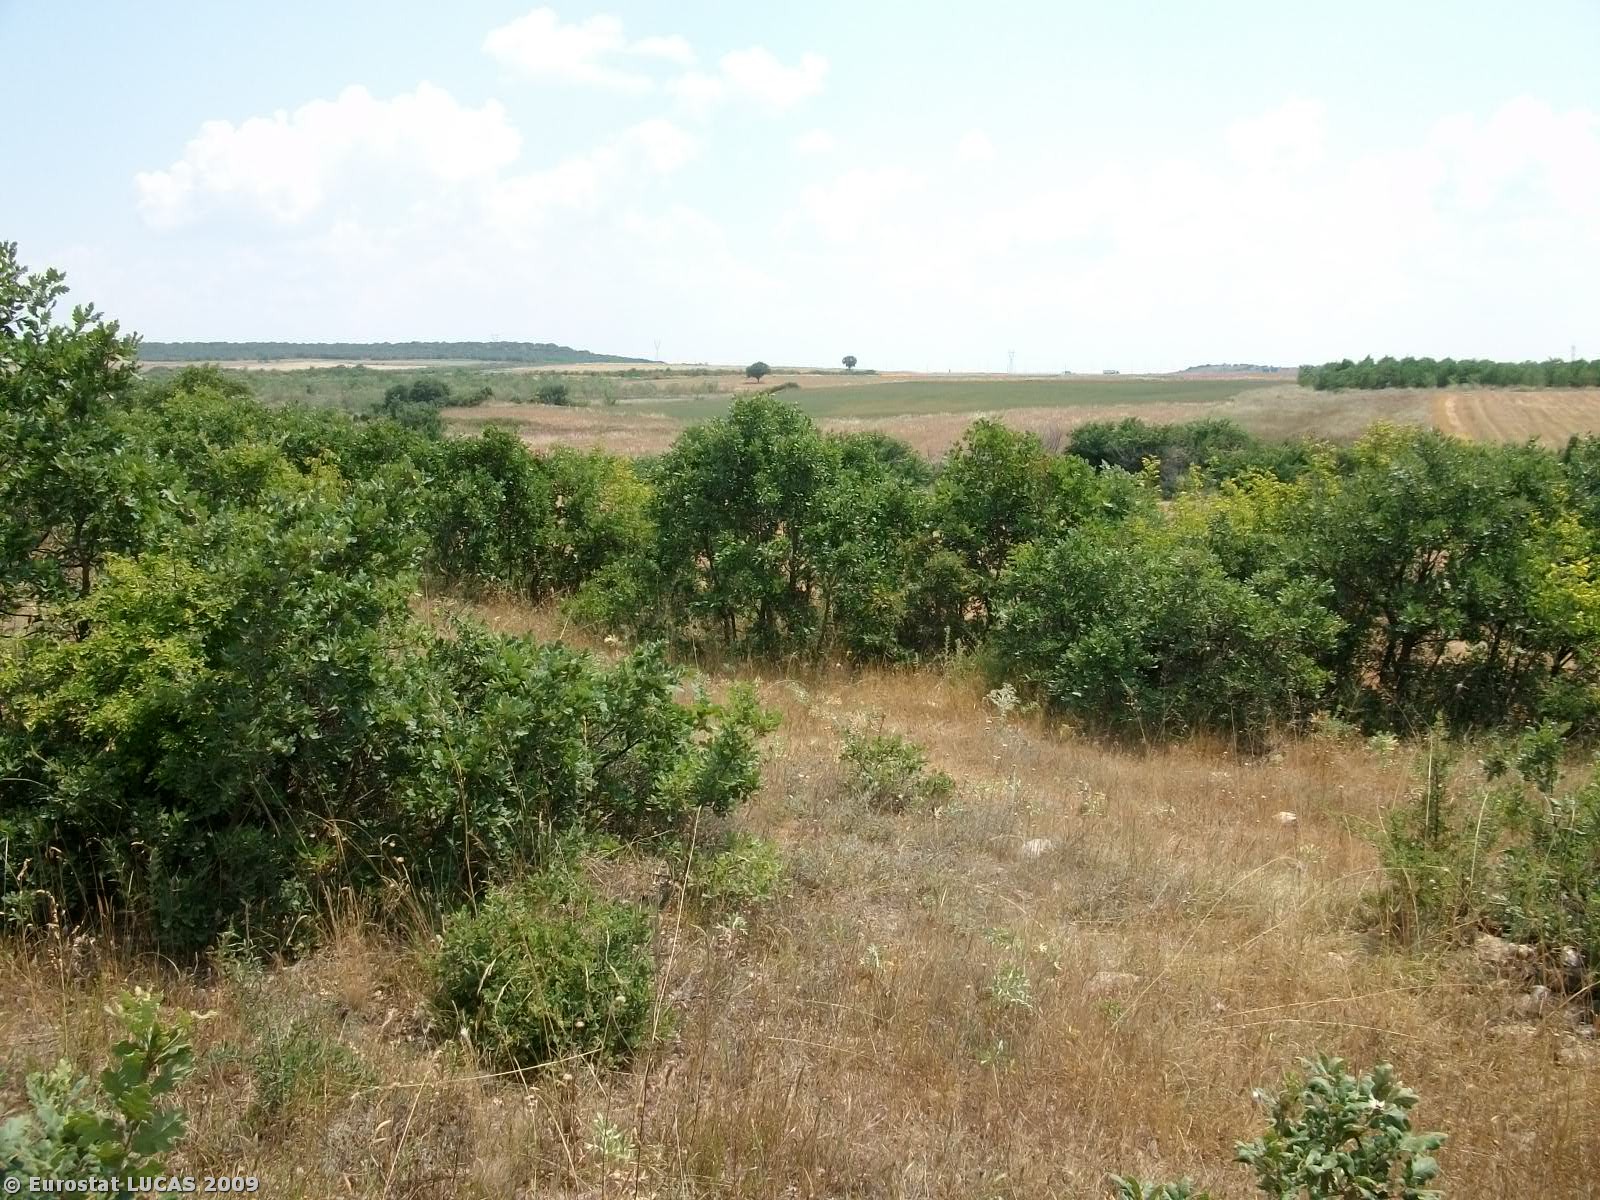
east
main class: Shrubland
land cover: Shrubland with sparse tree cover
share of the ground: 25 - 50 %
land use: Unused
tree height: < 5 m
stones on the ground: 25 - 50 %
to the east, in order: Shrubland with sparse tree cover; Tracks; Shrubland with sparse tree cover; Durum wheat; Abandoned hedges; Rivers and streams; Abandoned hedges; Durum wheat; Lucerne
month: July
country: GR
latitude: 40.9520
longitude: 26.2092
